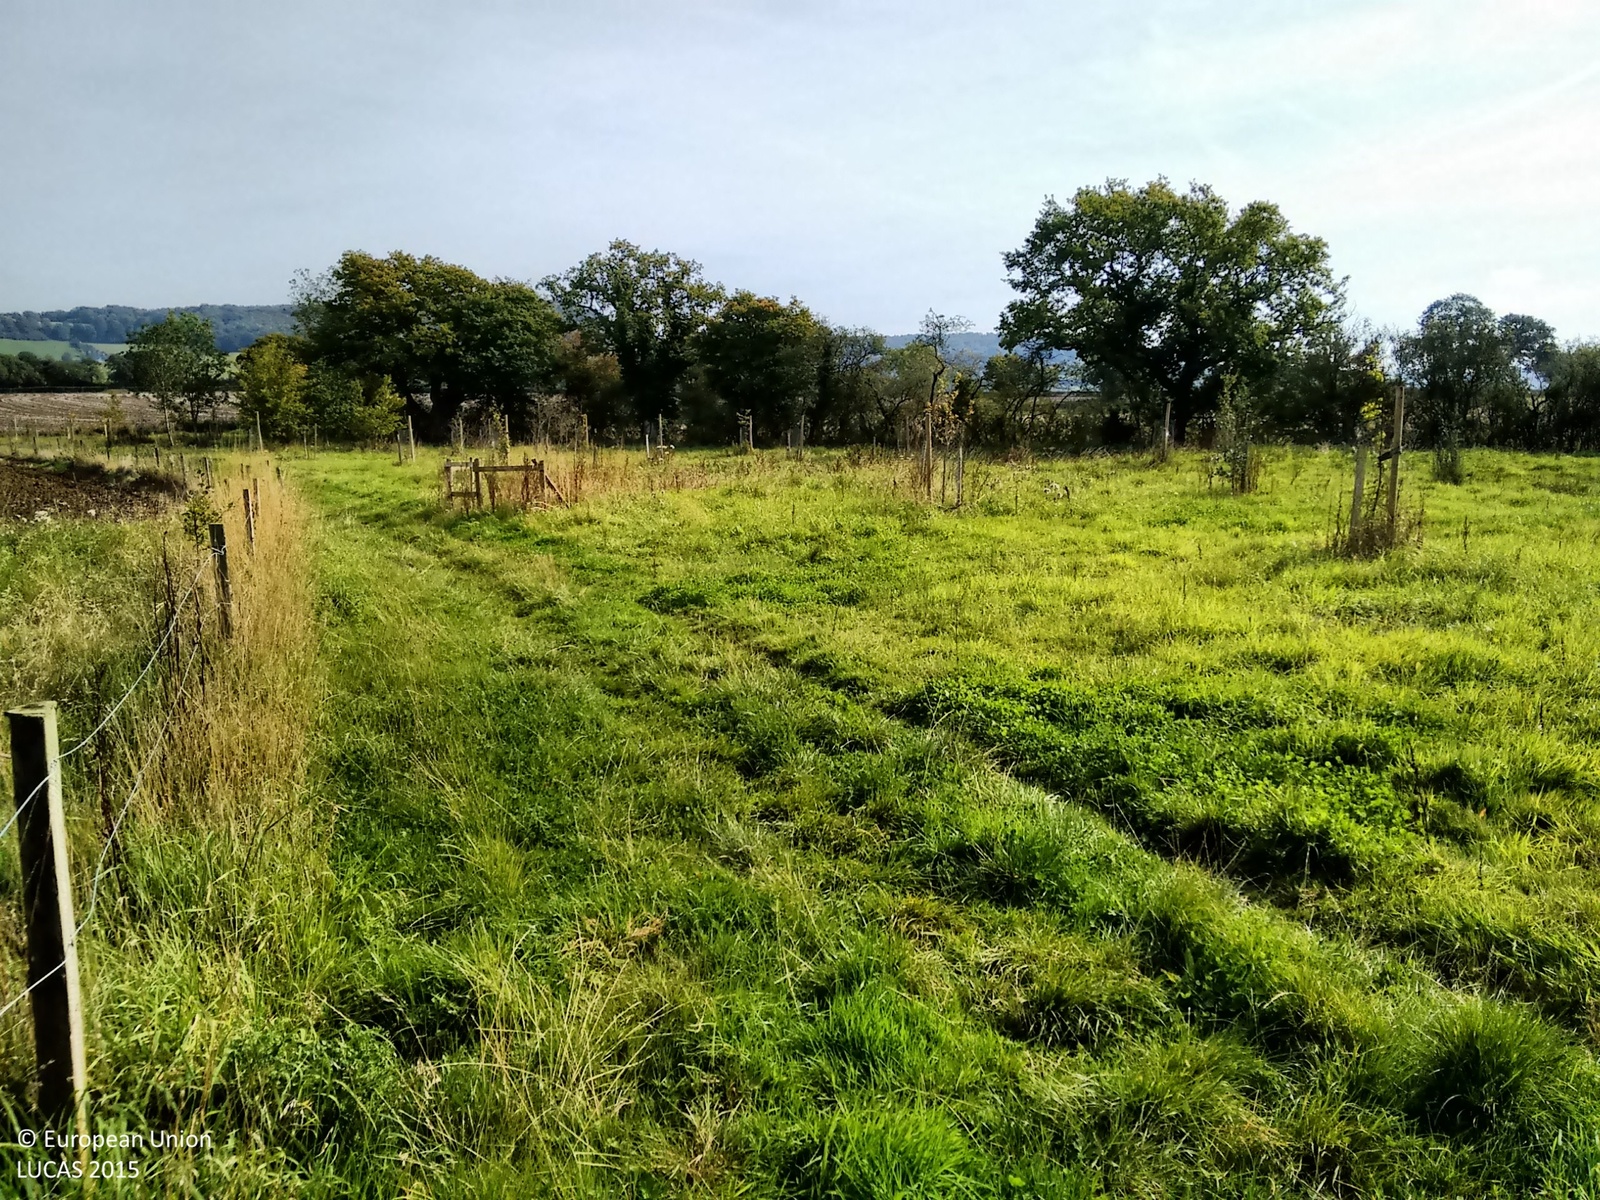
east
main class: Grassland
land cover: Grassland without tree/shrub cover
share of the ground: > 75 %
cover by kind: herbaceous plants 100 %
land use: Agriculture (excluding fallow land and kitchen gardens)
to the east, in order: Grassland without tree/shrub cover; Grassland with sparse tree/shrub cover; Ditches and canals; Grassland with sparse tree/shrub cover; Ditches and canals; Abandoned hedges; Spontaneously vegetated surfaces; Fences; Managed hedges; Ditches and canals; Grass margins; Other bare soil
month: September
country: GB
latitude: 51.6521
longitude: -2.3938
